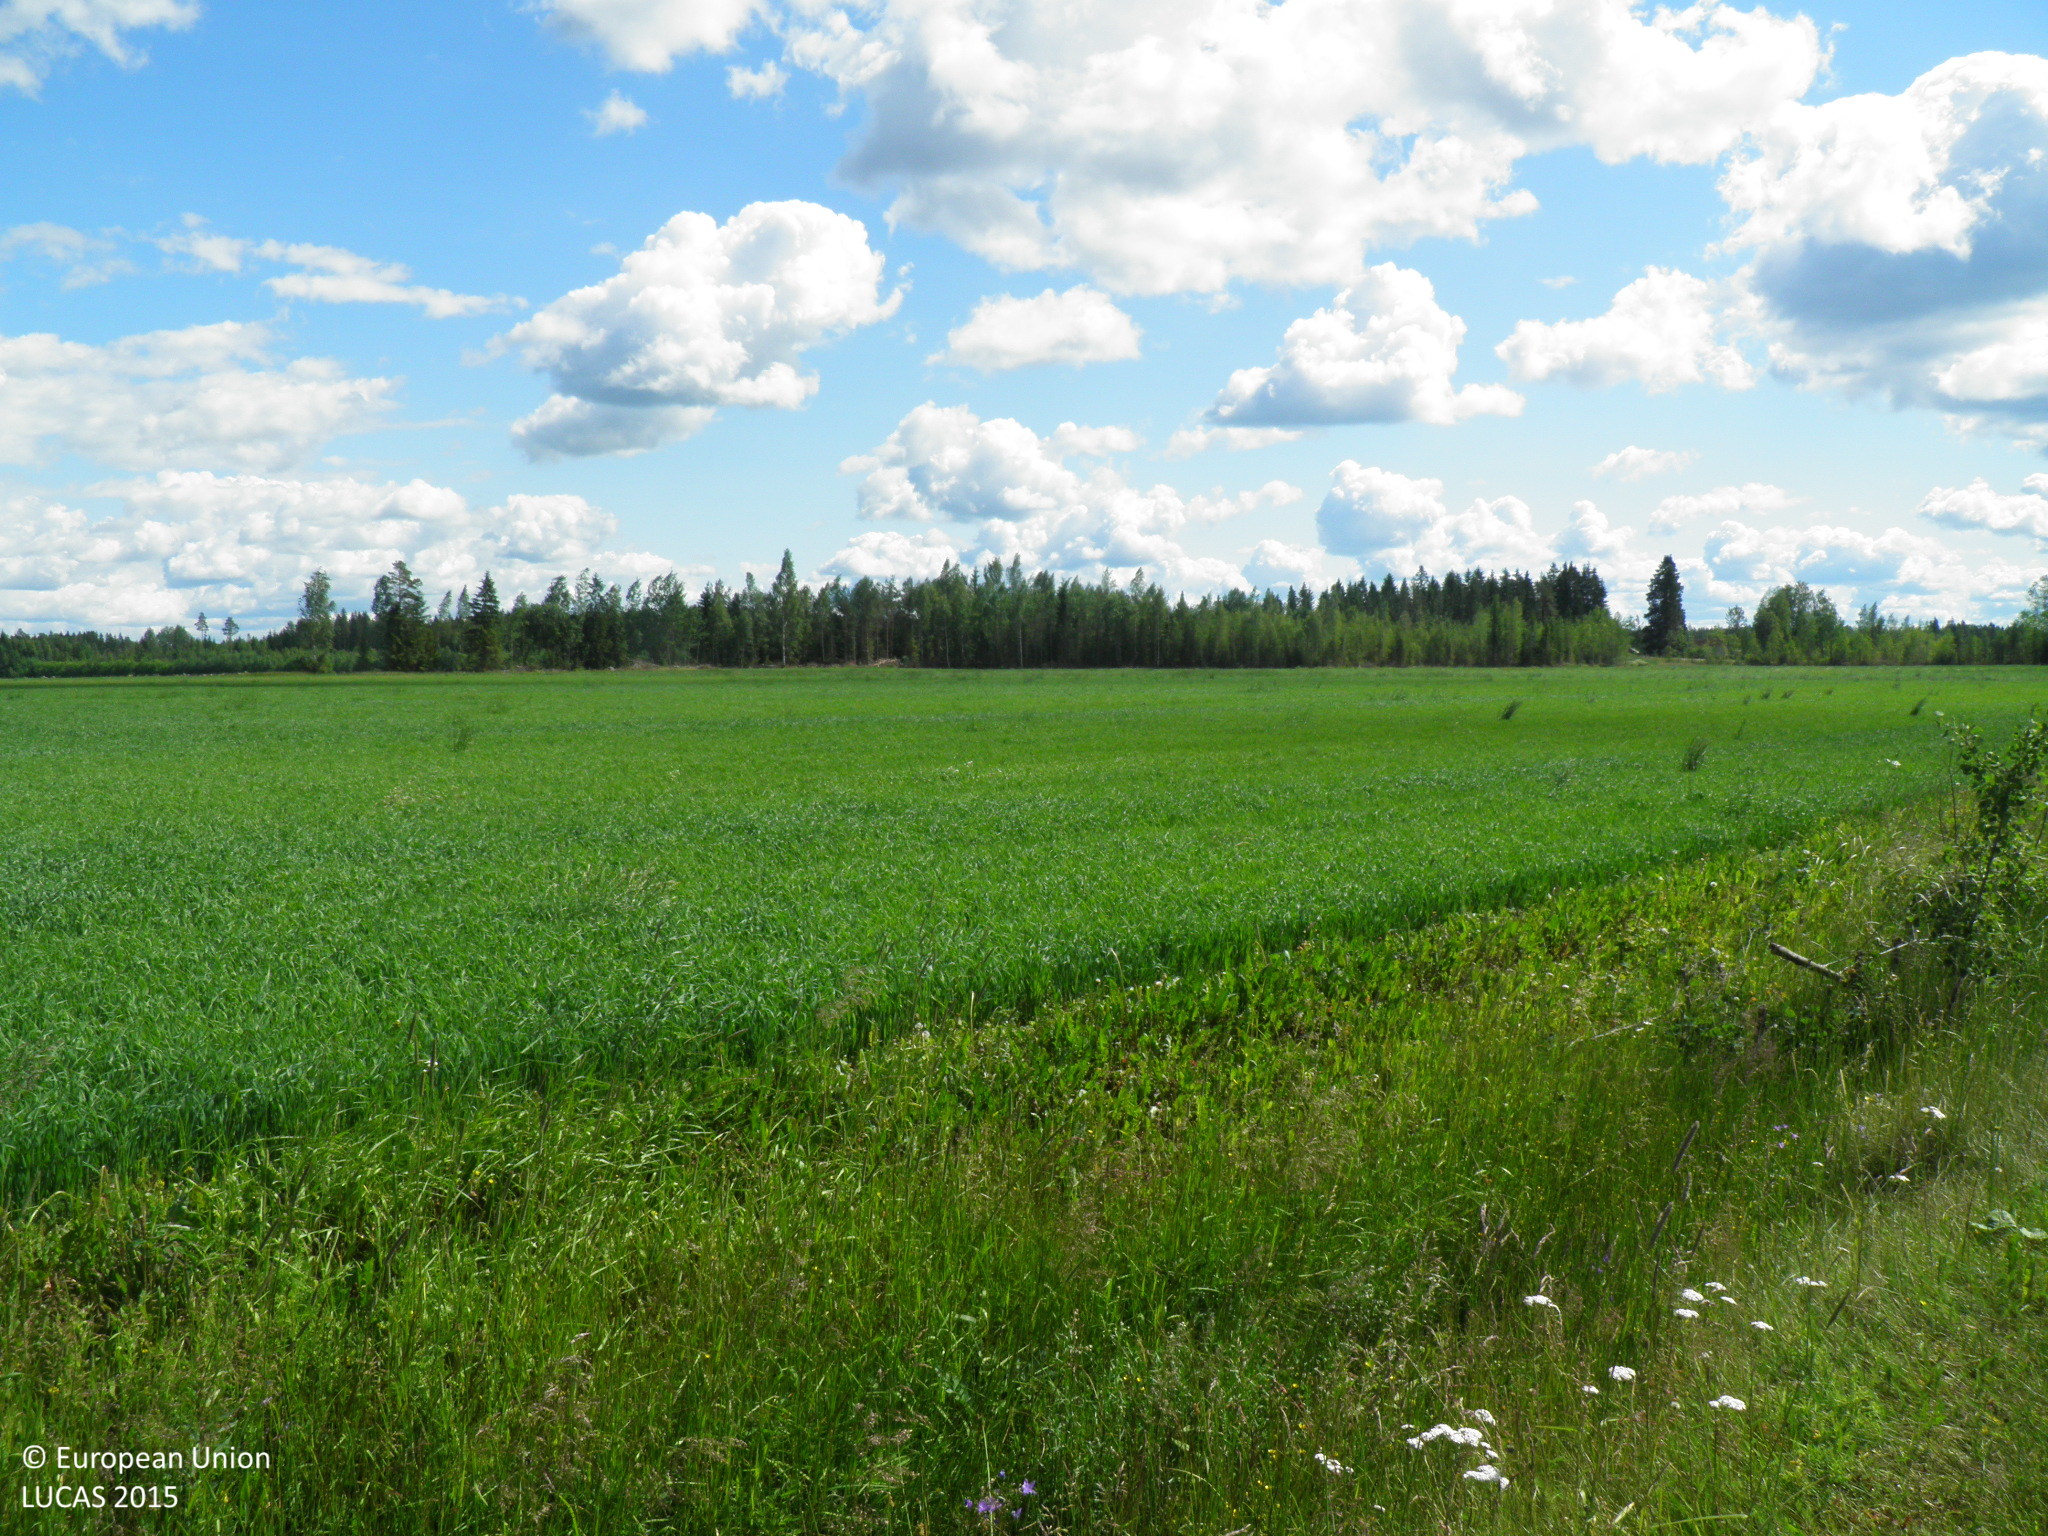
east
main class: Cropland
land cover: Oats
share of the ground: > 75 %
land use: Agriculture (excluding fallow land and kitchen gardens)
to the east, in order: Oats; Grass margins; Tracks; Grass margins; Ditches and canals; Grass margins; Oats
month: July
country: FI
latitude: 60.5687
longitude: 22.9387
